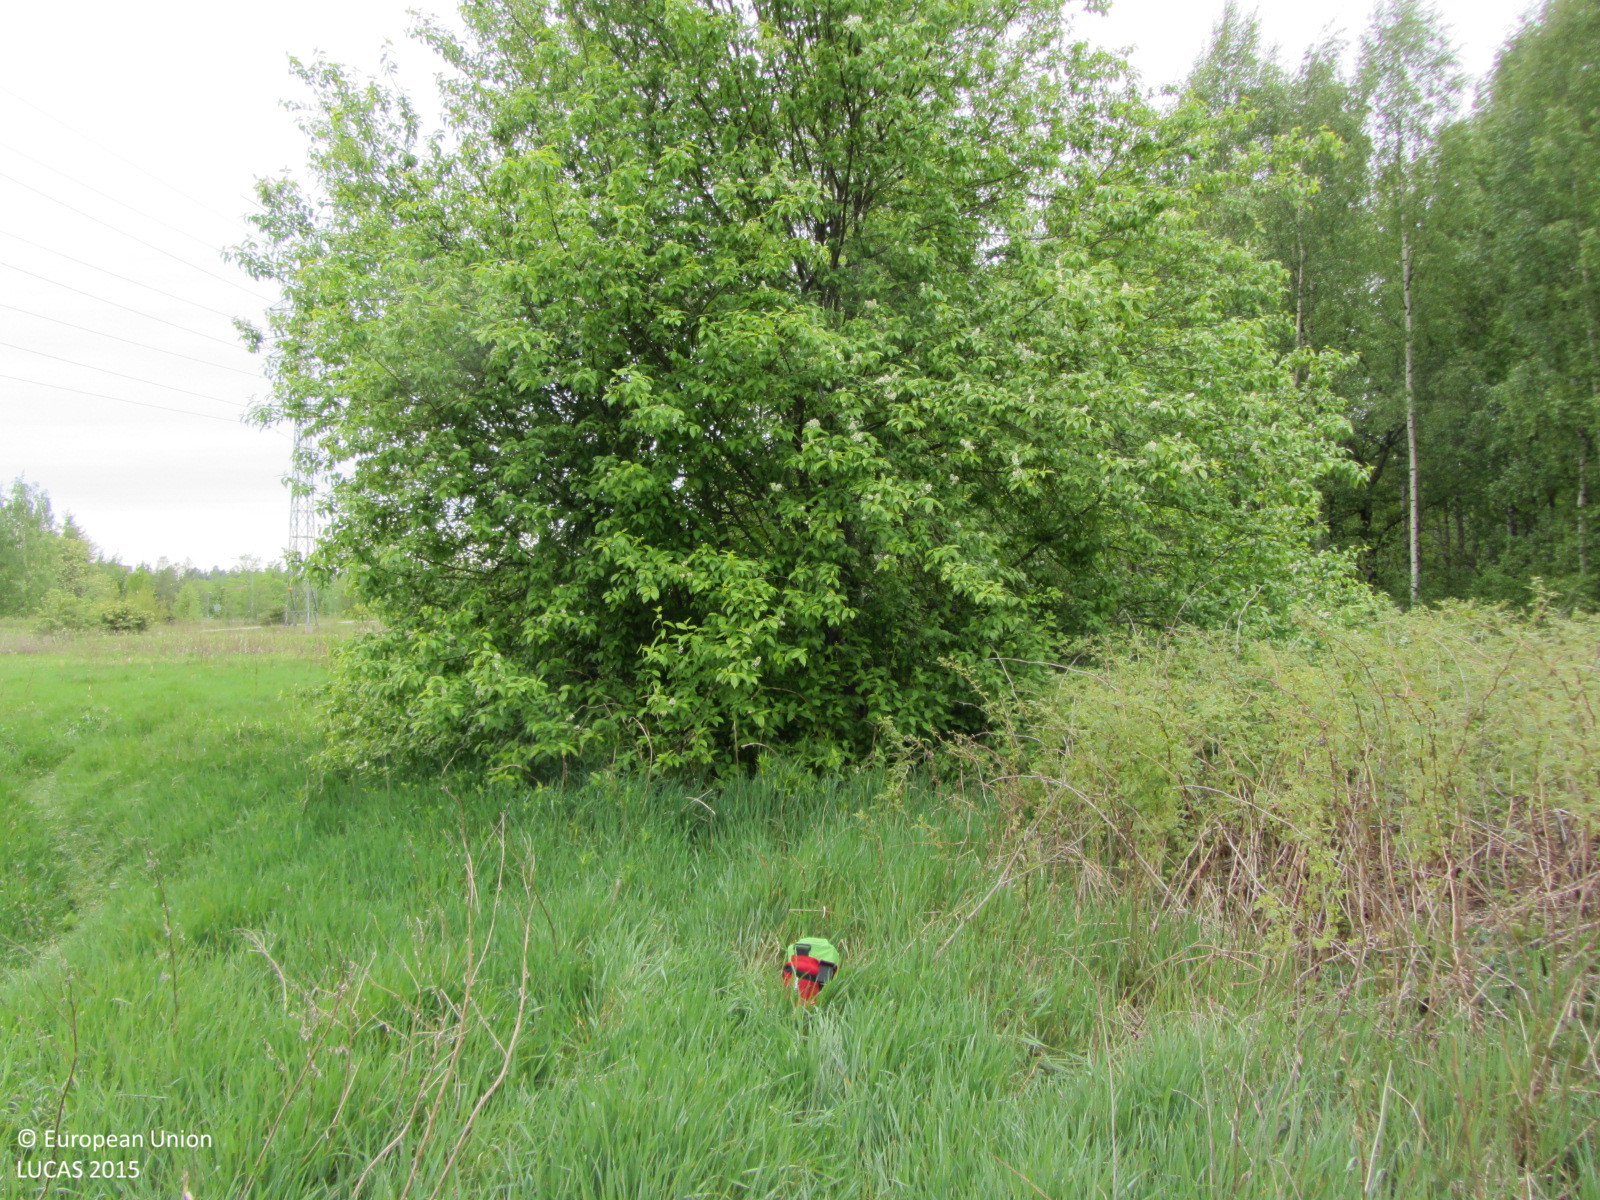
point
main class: Grassland
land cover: Grassland with sparse tree/shrub cover
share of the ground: > 75 %
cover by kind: herbaceous plants 85 %, shrubs 10 %, broadleaved forest trees 5 %
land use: Semi-natural and natural areas not in use
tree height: < 5 m
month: June
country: FI
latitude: 60.1860
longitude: 24.7742
